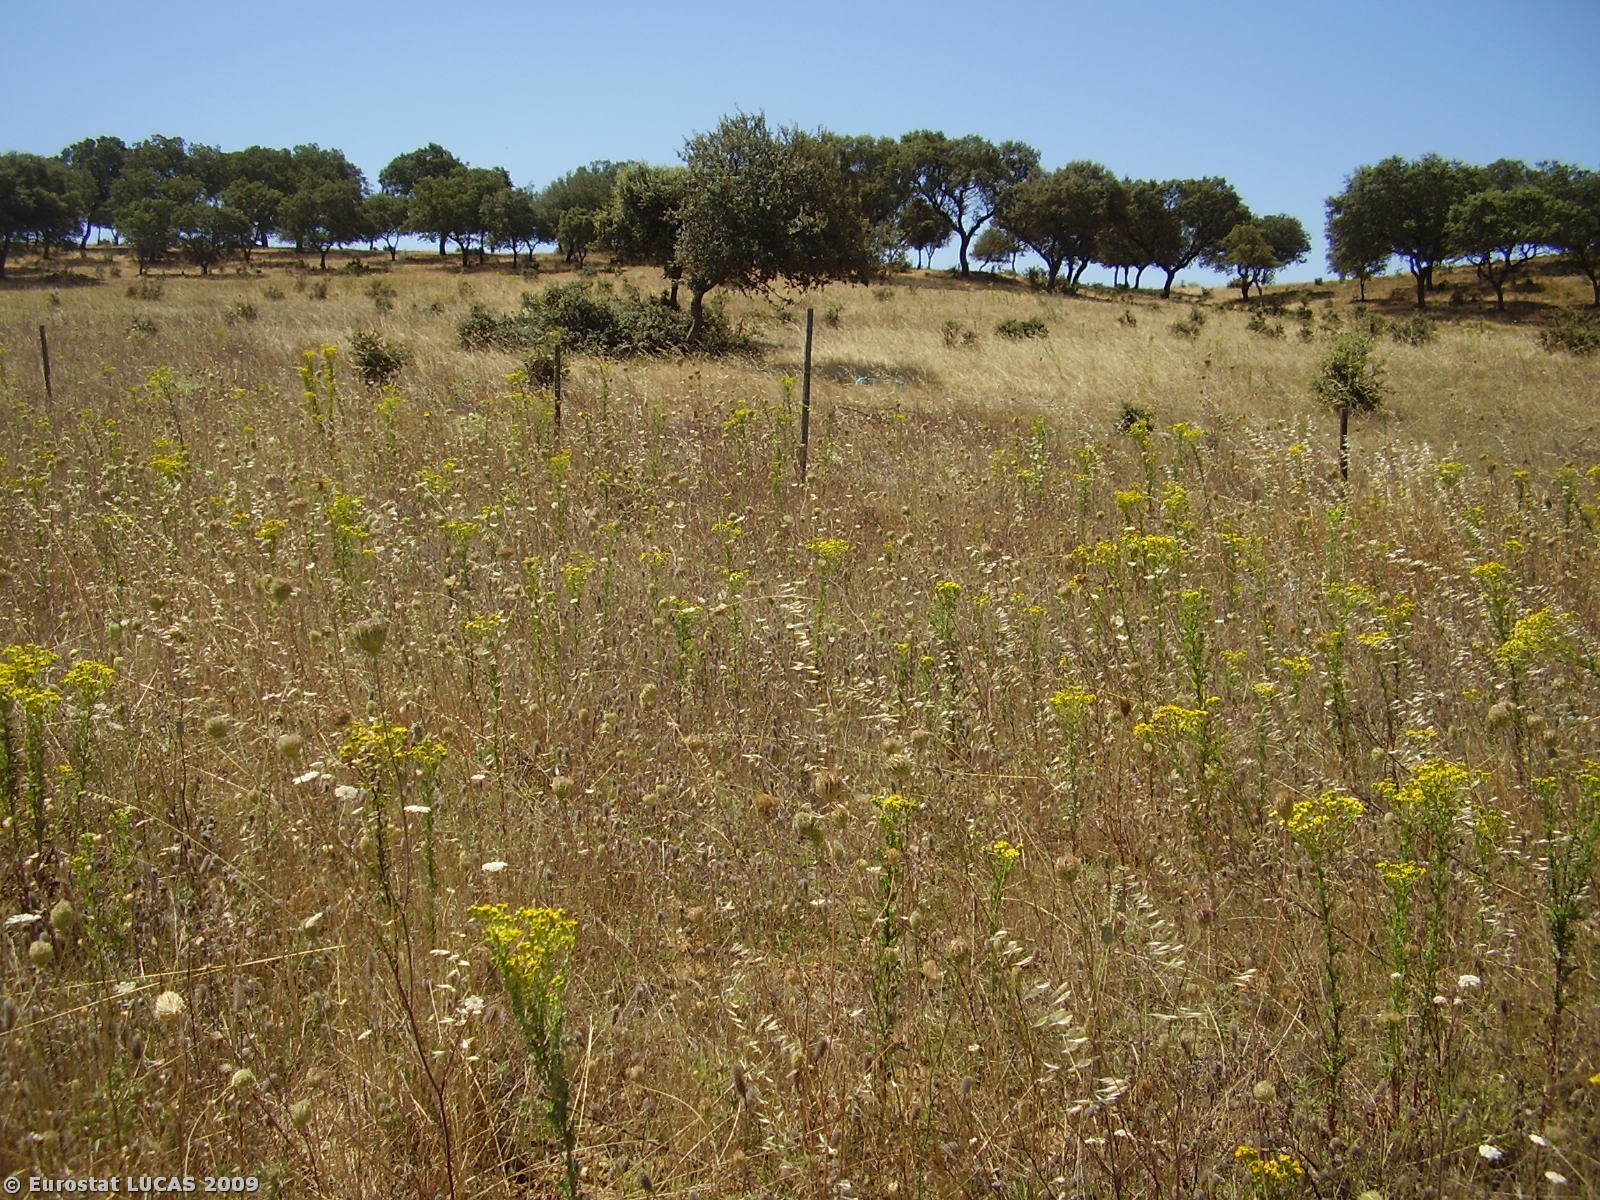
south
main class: Grassland
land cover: Spontaneously vegetated surfaces
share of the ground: > 75 %
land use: Fallow land
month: July
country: PT
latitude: 38.6902
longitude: -7.9430
